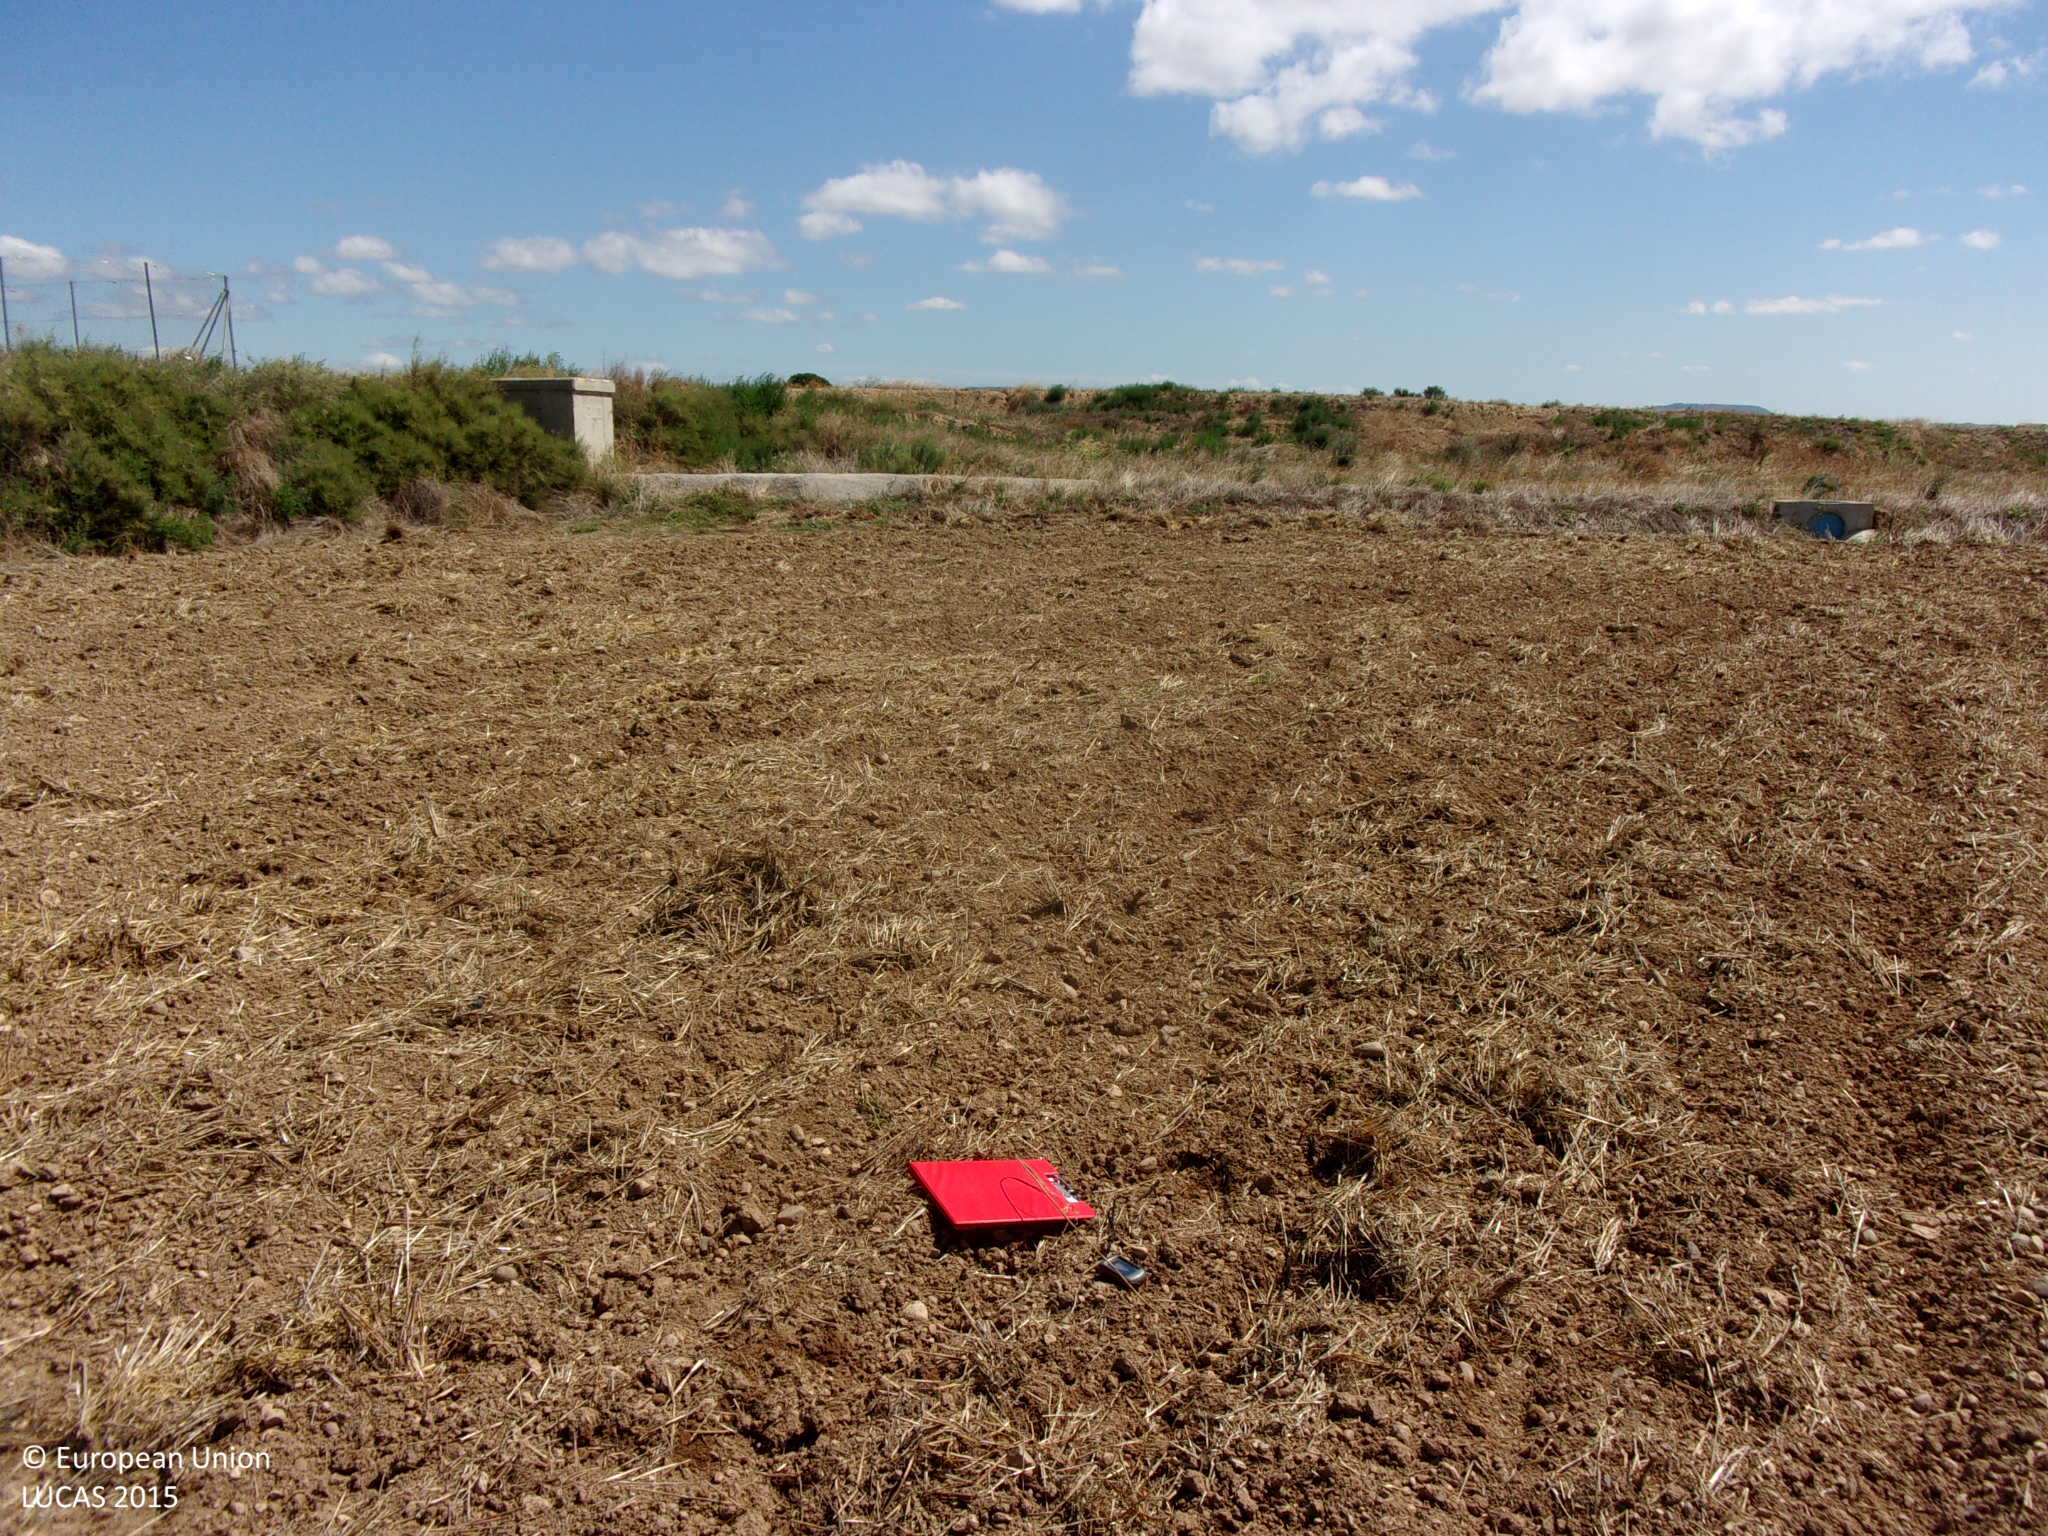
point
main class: Cropland
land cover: Barley
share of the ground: < 10 %
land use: Agriculture (excluding fallow land and kitchen gardens)
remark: Harvested field
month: August
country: ES
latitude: 42.1307
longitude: -1.1215
